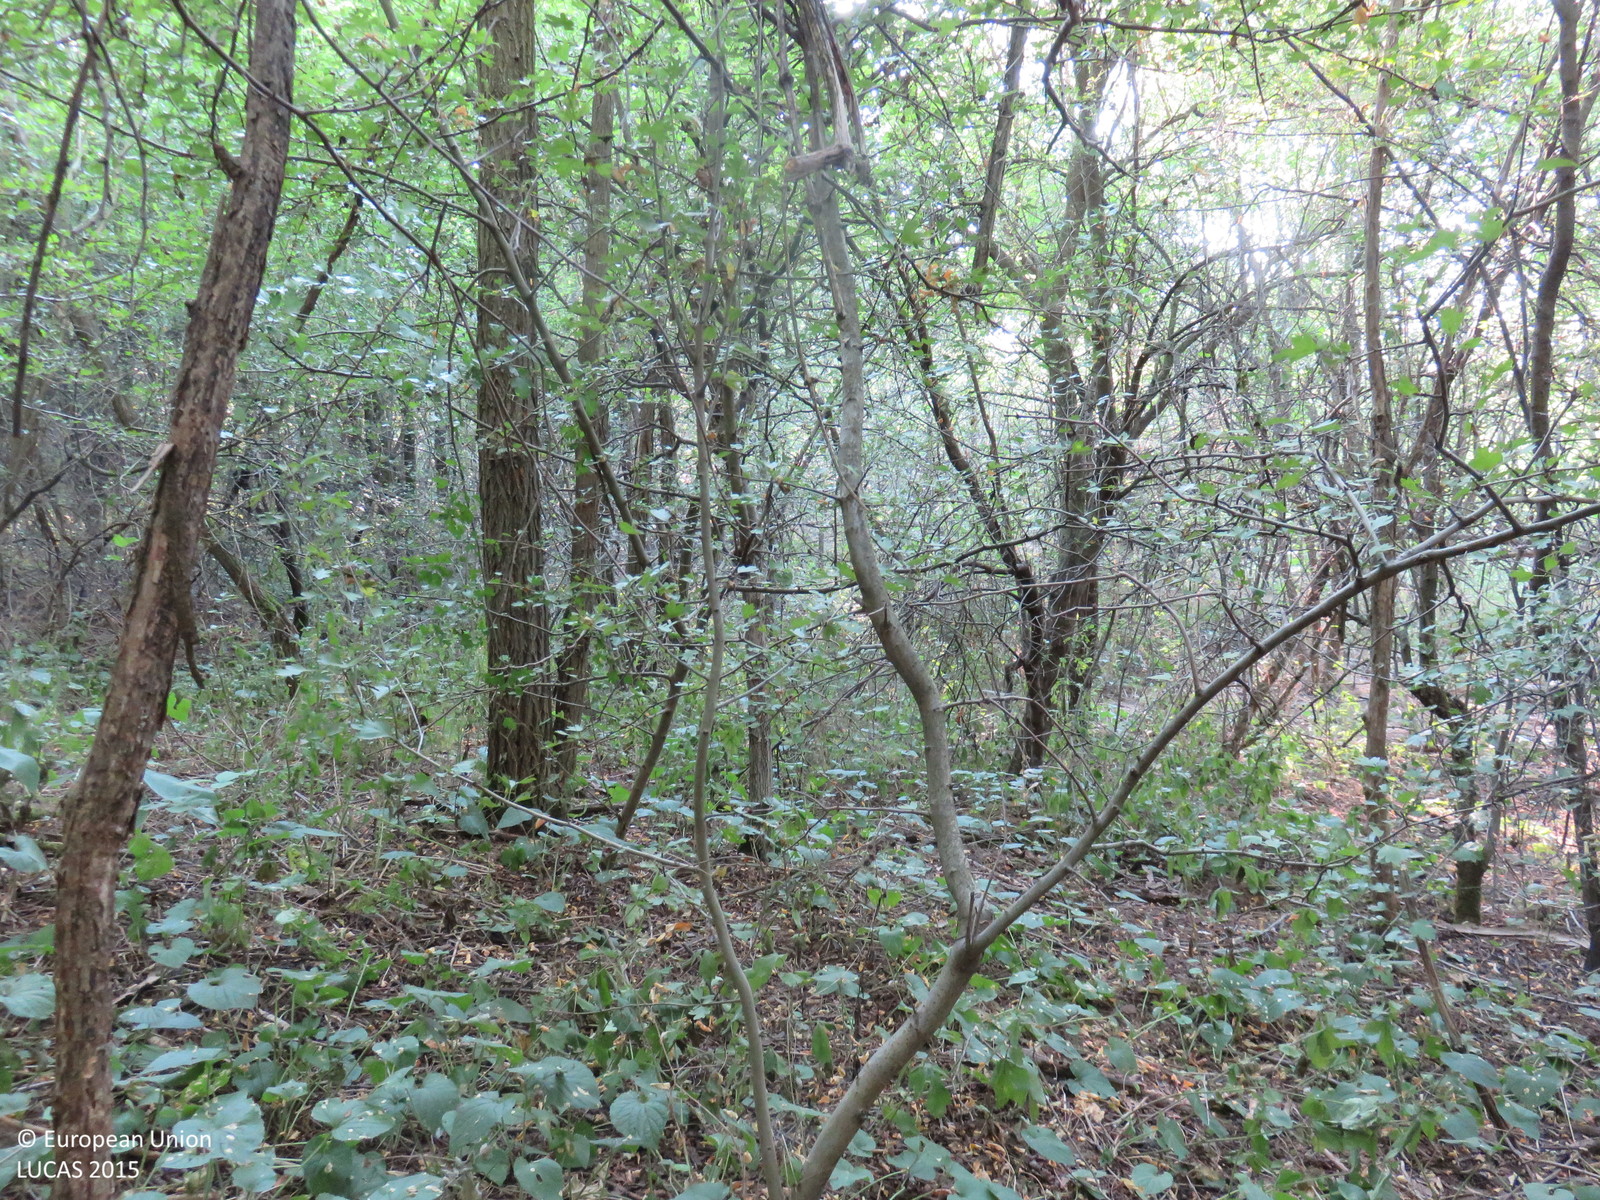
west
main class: Woodland
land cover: Broadleaved woodland
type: mesophytic deciduous forest
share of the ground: > 75 %
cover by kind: broadleaved forest trees 95 %, shrubs 5 %
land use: Forestry
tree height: > 5 m
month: July
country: BG
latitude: 43.5938
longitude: 25.0486
